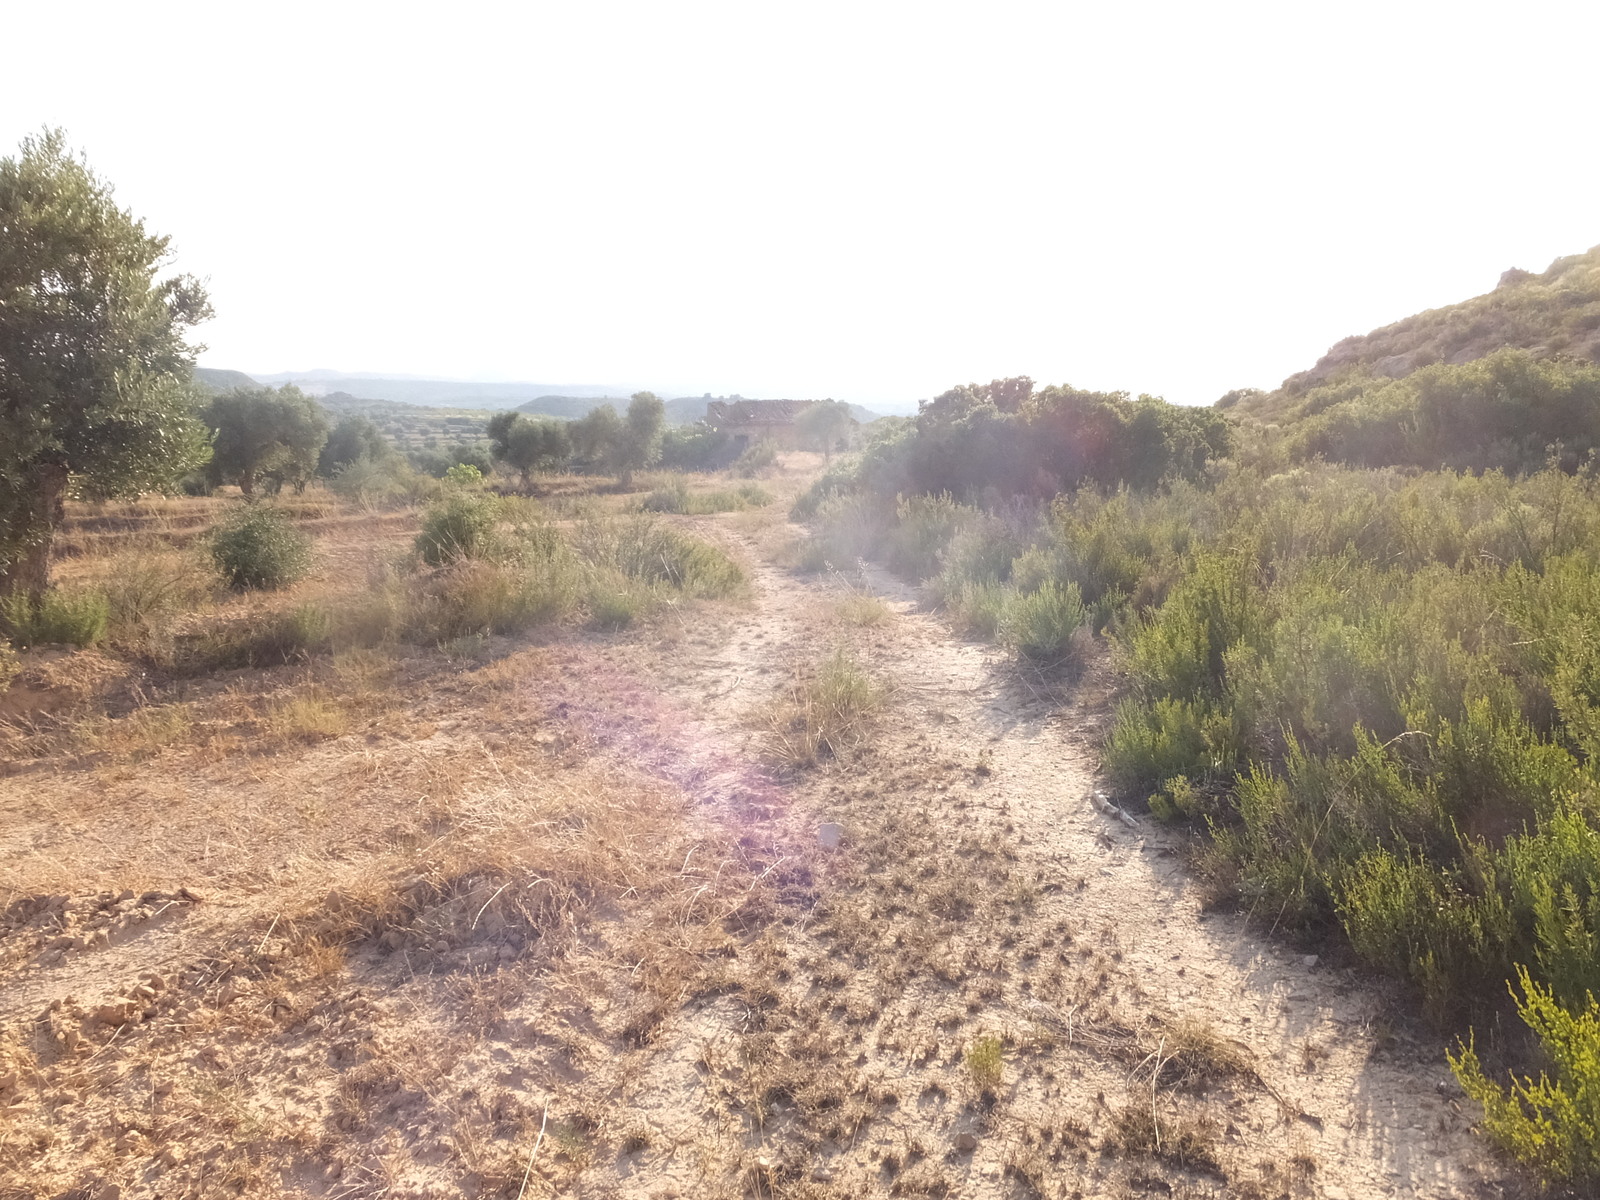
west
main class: Shrubland
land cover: Shrubland without tree cover
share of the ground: > 75 %
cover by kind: consolidated bare surface 60 %, shrubs 20 %, herbaceous plants 20 %
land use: Semi-natural and natural areas not in use
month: July
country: ES
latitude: 41.1550
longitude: 0.1582
